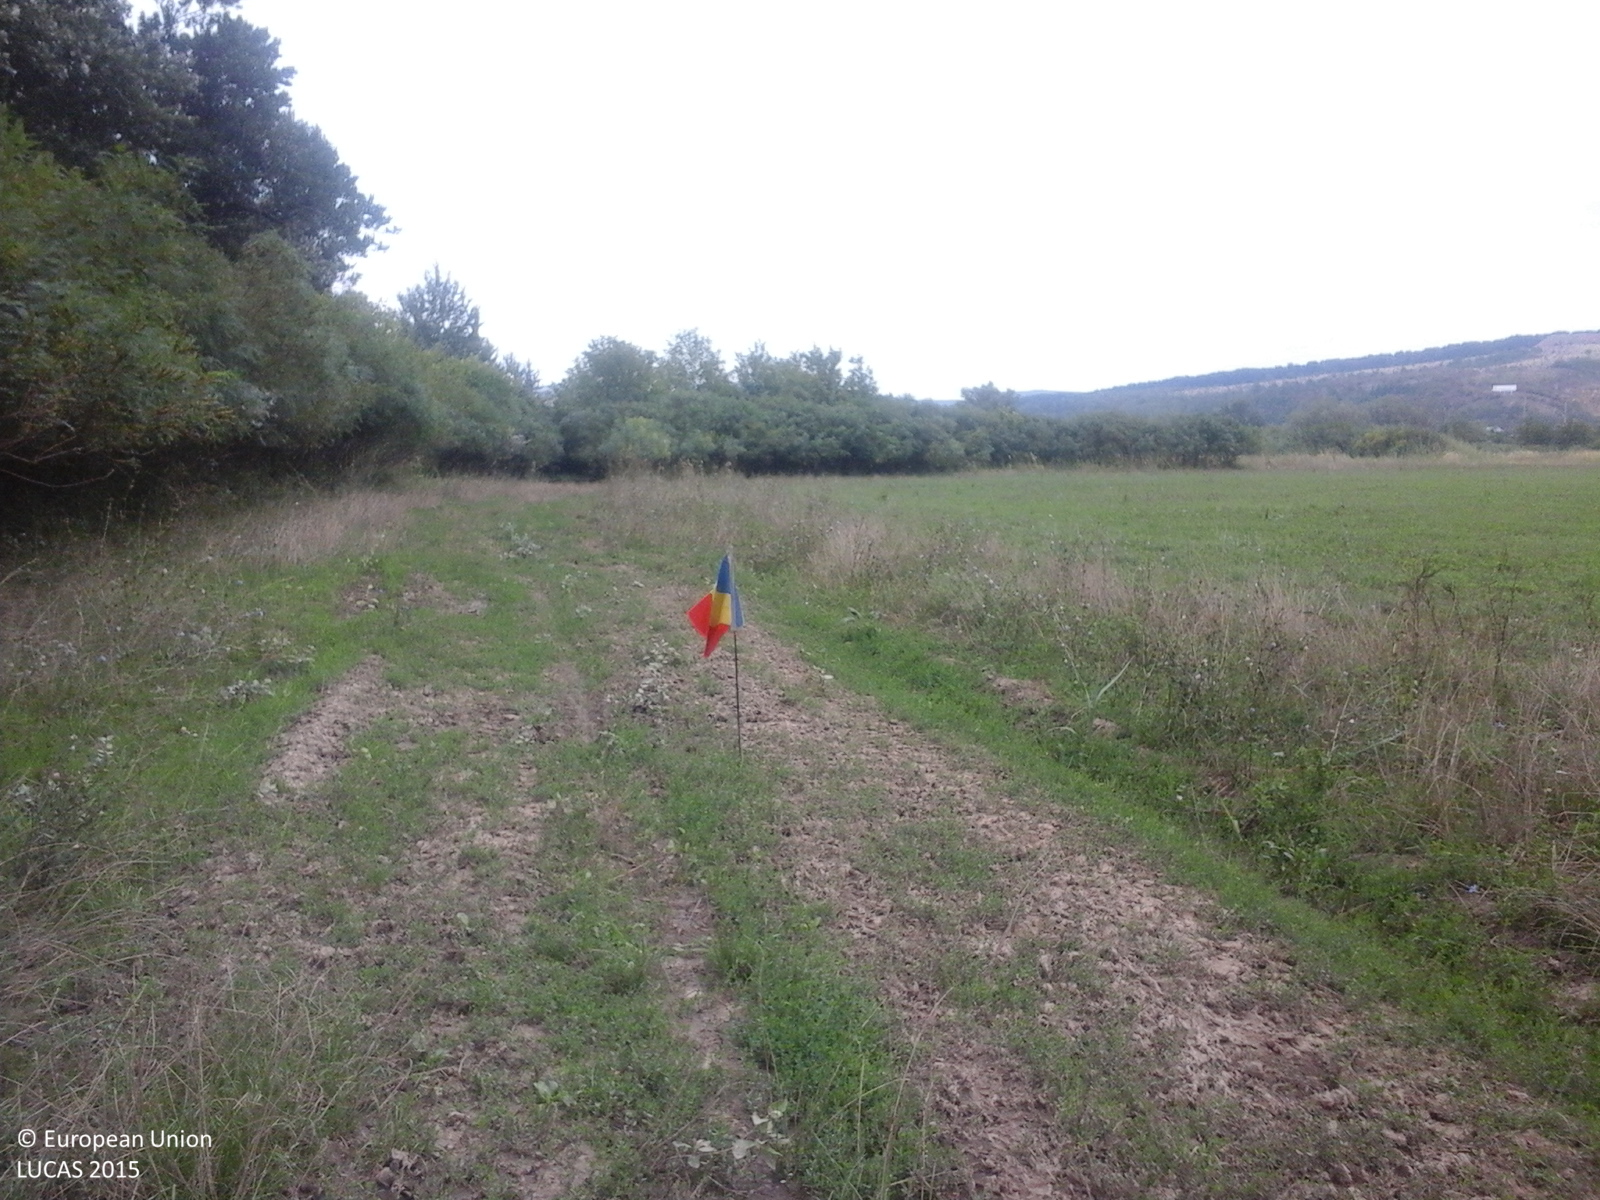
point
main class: Cropland
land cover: Lucerne
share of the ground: > 75 %
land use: Agriculture (excluding fallow land and kitchen gardens)
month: August
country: RO
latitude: 46.0925
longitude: 21.6654
